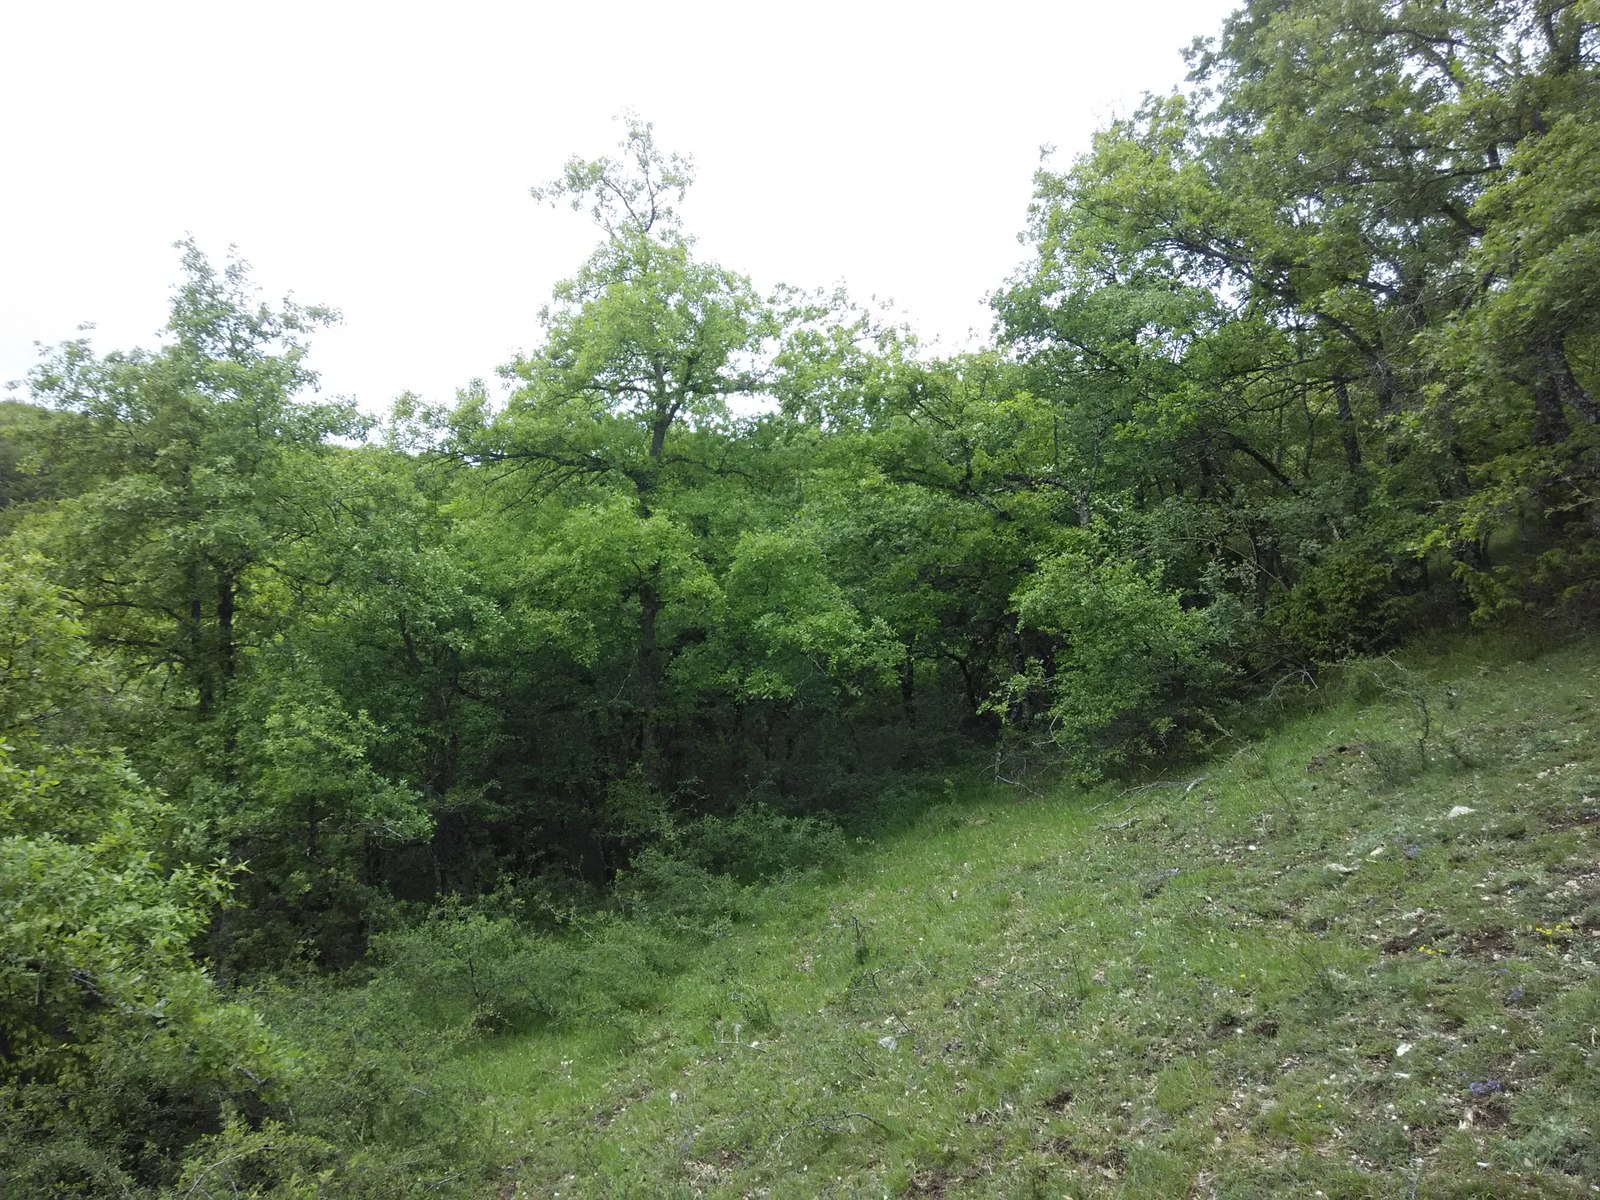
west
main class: Woodland
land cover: Broadleaved woodland
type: beech forest
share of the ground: > 75 %
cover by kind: broadleaved forest trees 85 %, coniferous forest trees 10 %, shrubs 5 %
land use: Forestry
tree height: > 5 m
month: May
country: ES
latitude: 42.7704
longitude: -2.5019
